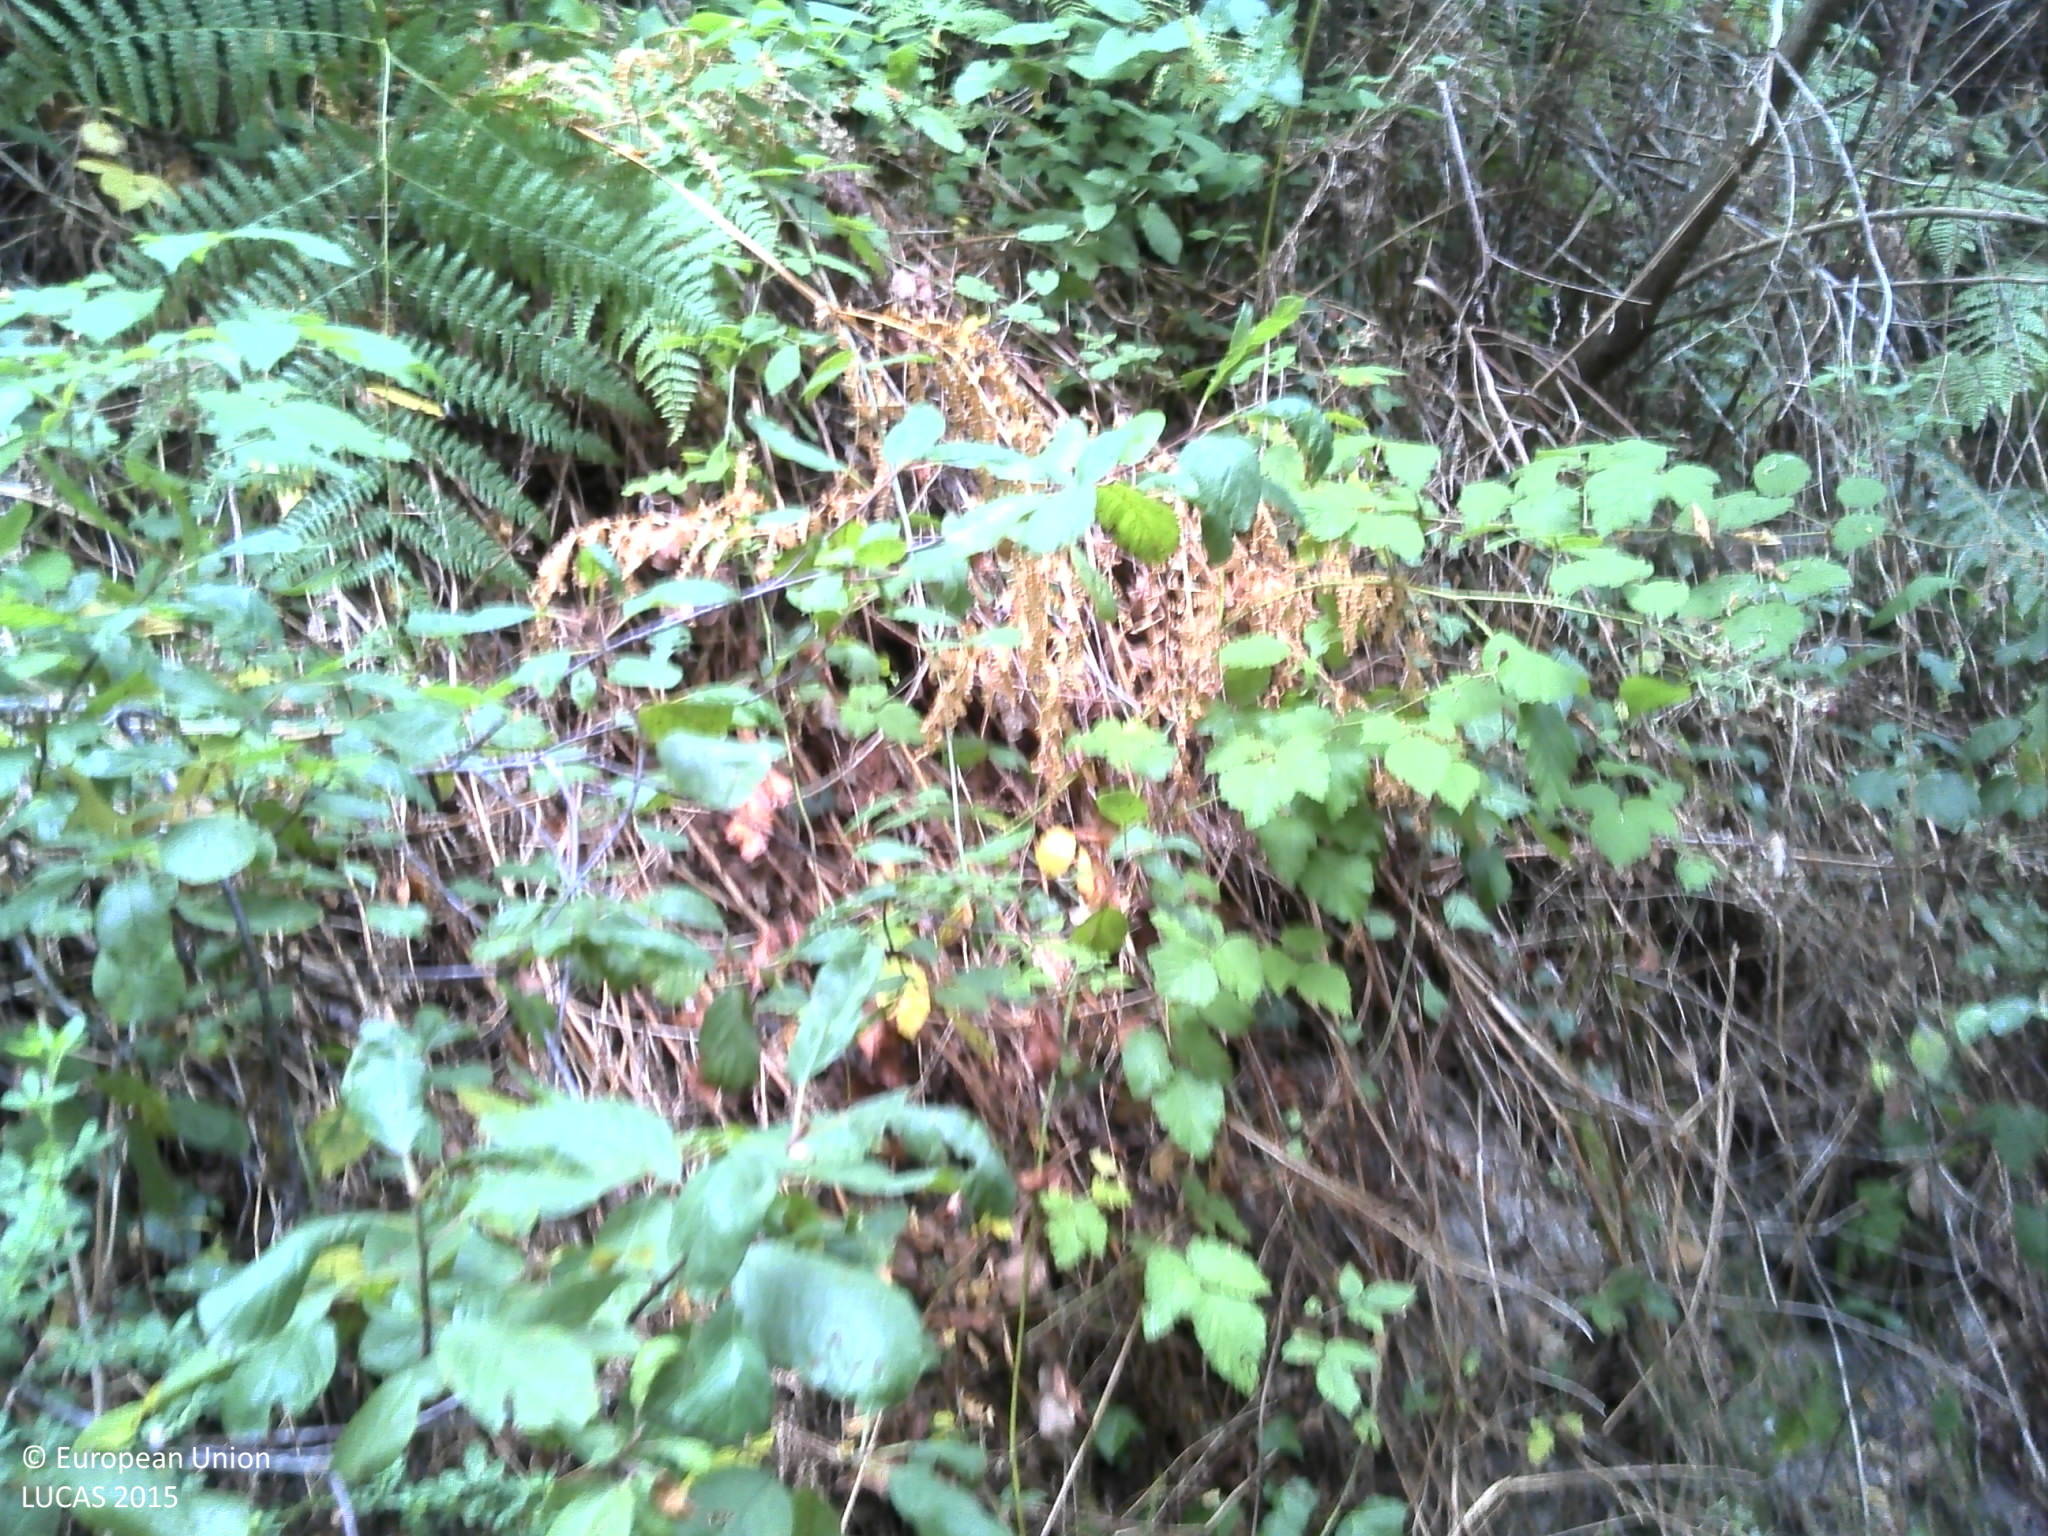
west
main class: Woodland
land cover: Broadleaved woodland
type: thermophilous deciduous forest
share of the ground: > 75 %
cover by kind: broadleaved forest trees 75 %, shrubs 15 %, consolidated bare surface 5 %, unconsolidated bare surface 5 %
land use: Semi-natural and natural areas not in use
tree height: > 5 m
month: July
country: PT
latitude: 41.5445
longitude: -8.0896
